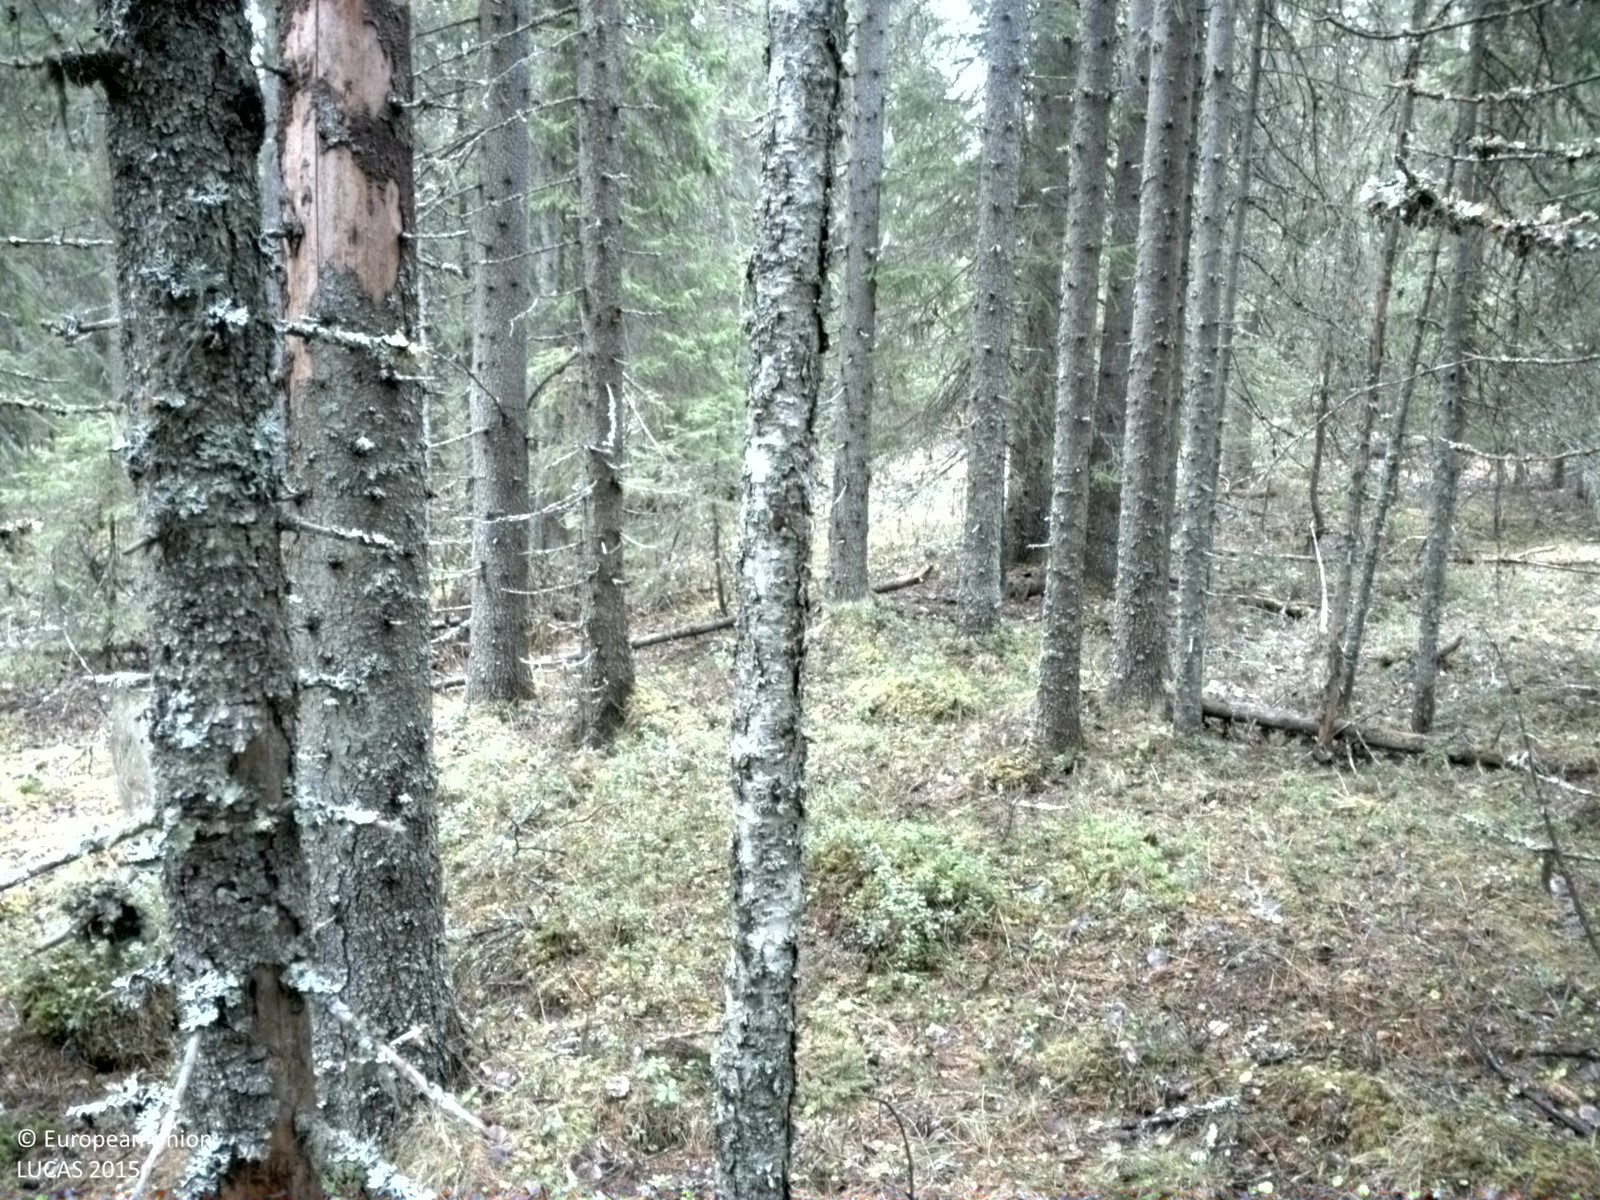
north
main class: Woodland
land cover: Spruce dominated coniferous woodland
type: boreal forest
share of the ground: > 75 %
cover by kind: coniferous forest trees 90 %, shrubs 5 %, lichens and mosses 5 %
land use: Forestry
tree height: > 5 m
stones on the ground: 10 - 25 %
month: May
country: SE
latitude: 63.4308
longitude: 13.8081
